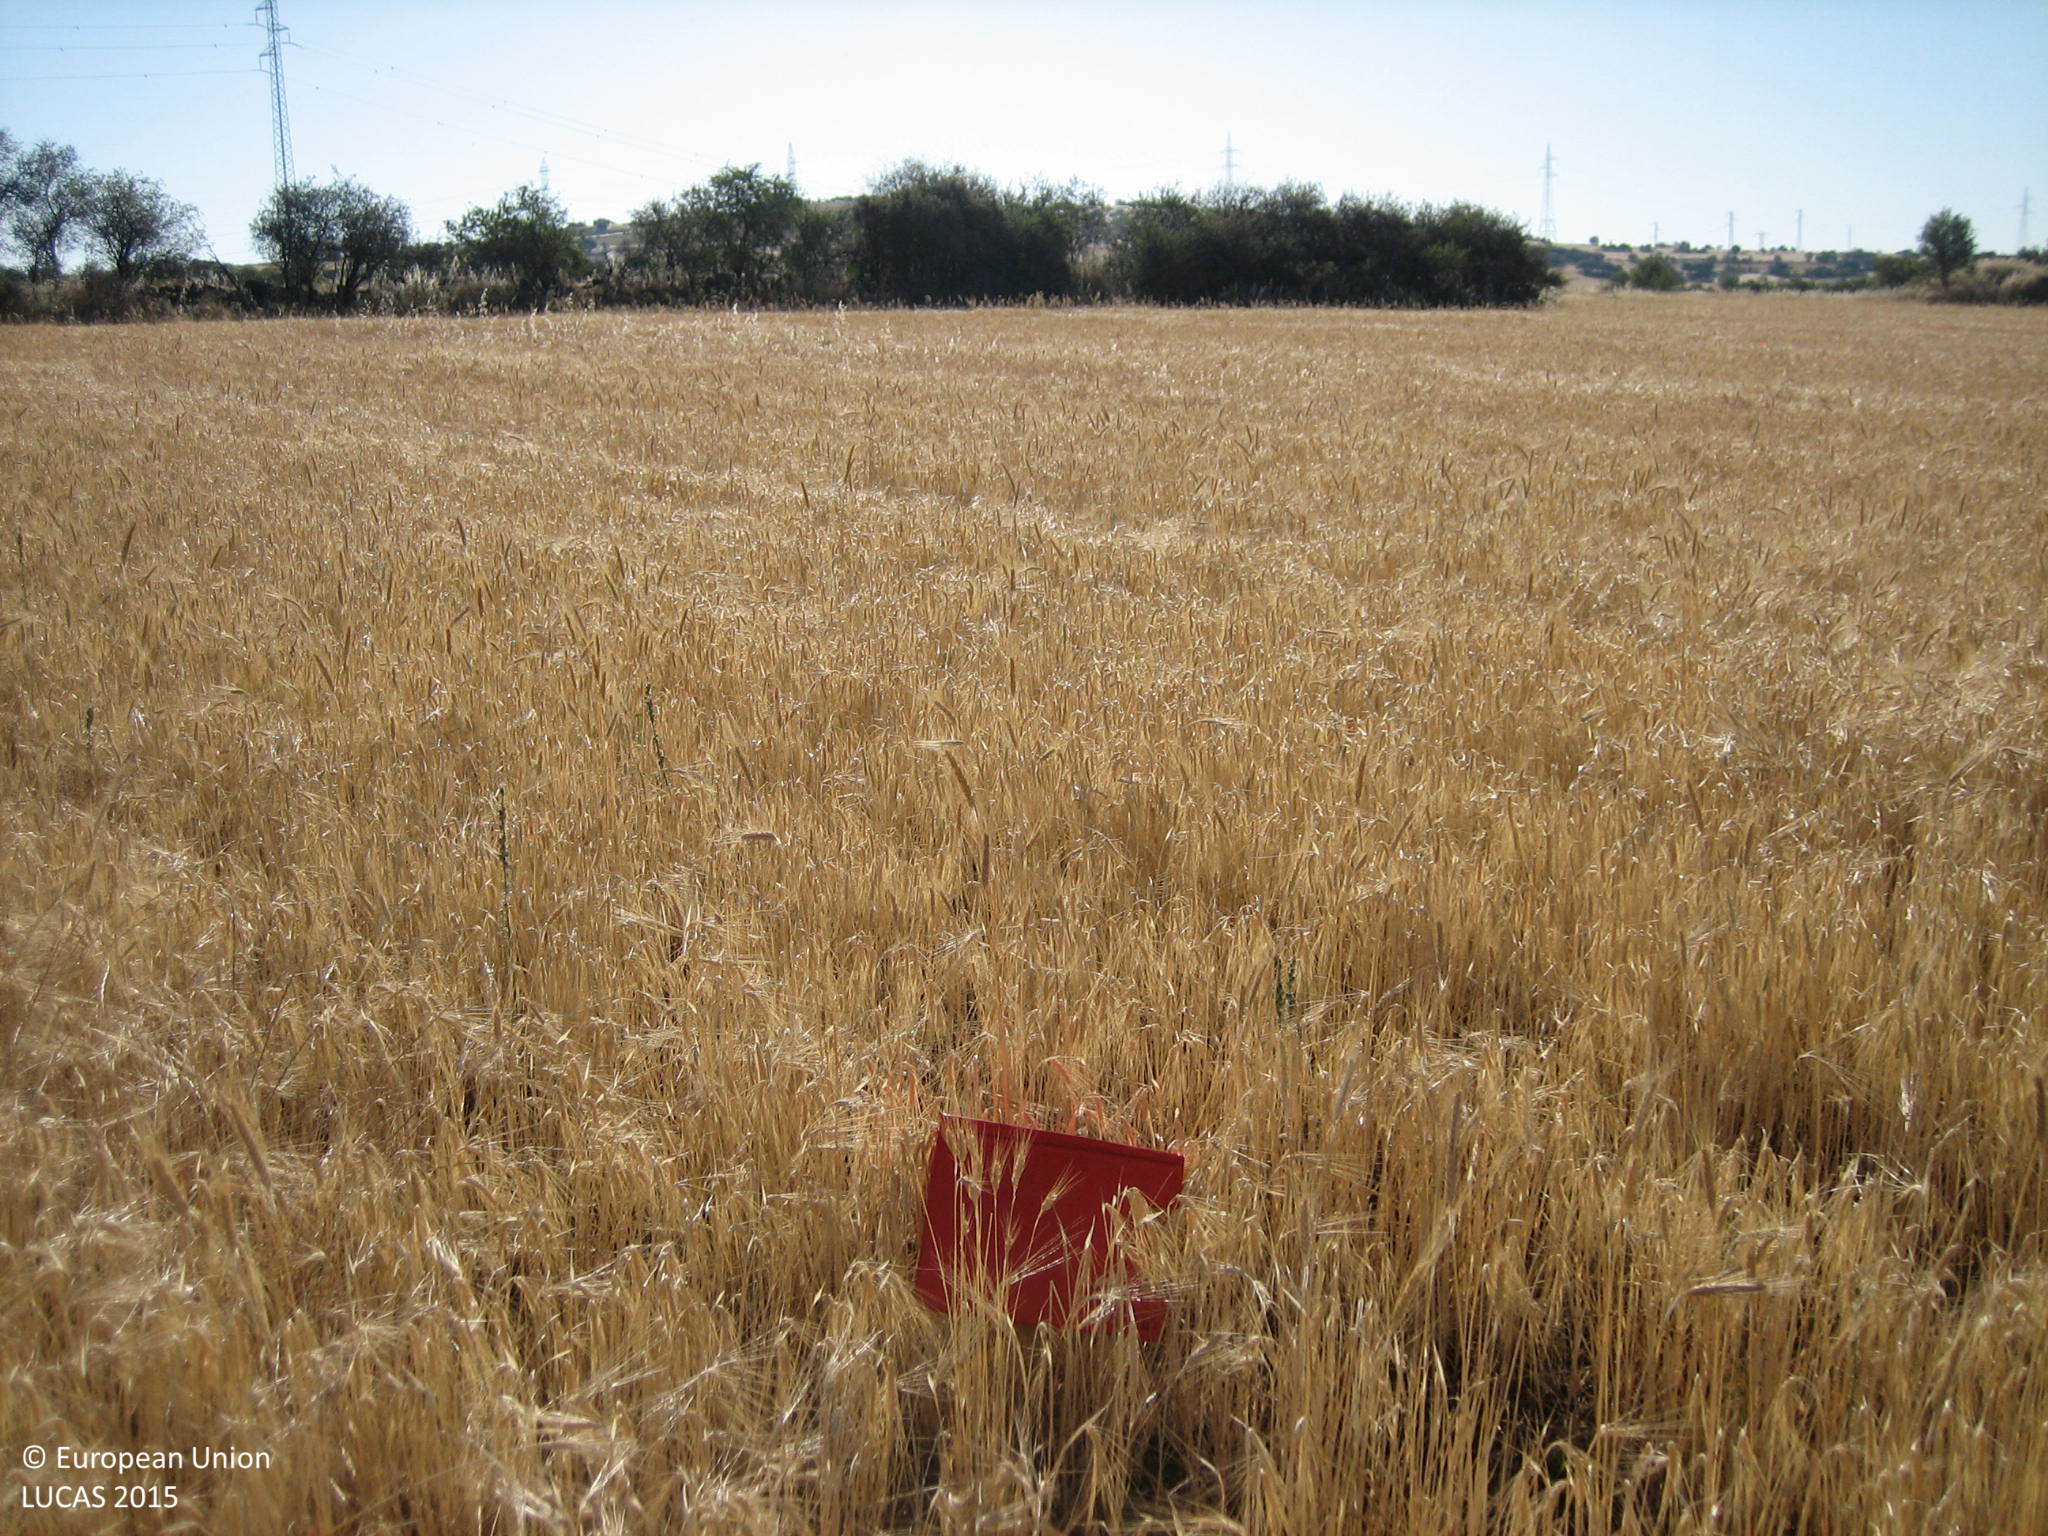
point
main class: Cropland
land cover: Barley
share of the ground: > 75 %
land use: Agriculture (excluding fallow land and kitchen gardens)
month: May
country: ES
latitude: 39.0050
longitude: -4.0994
